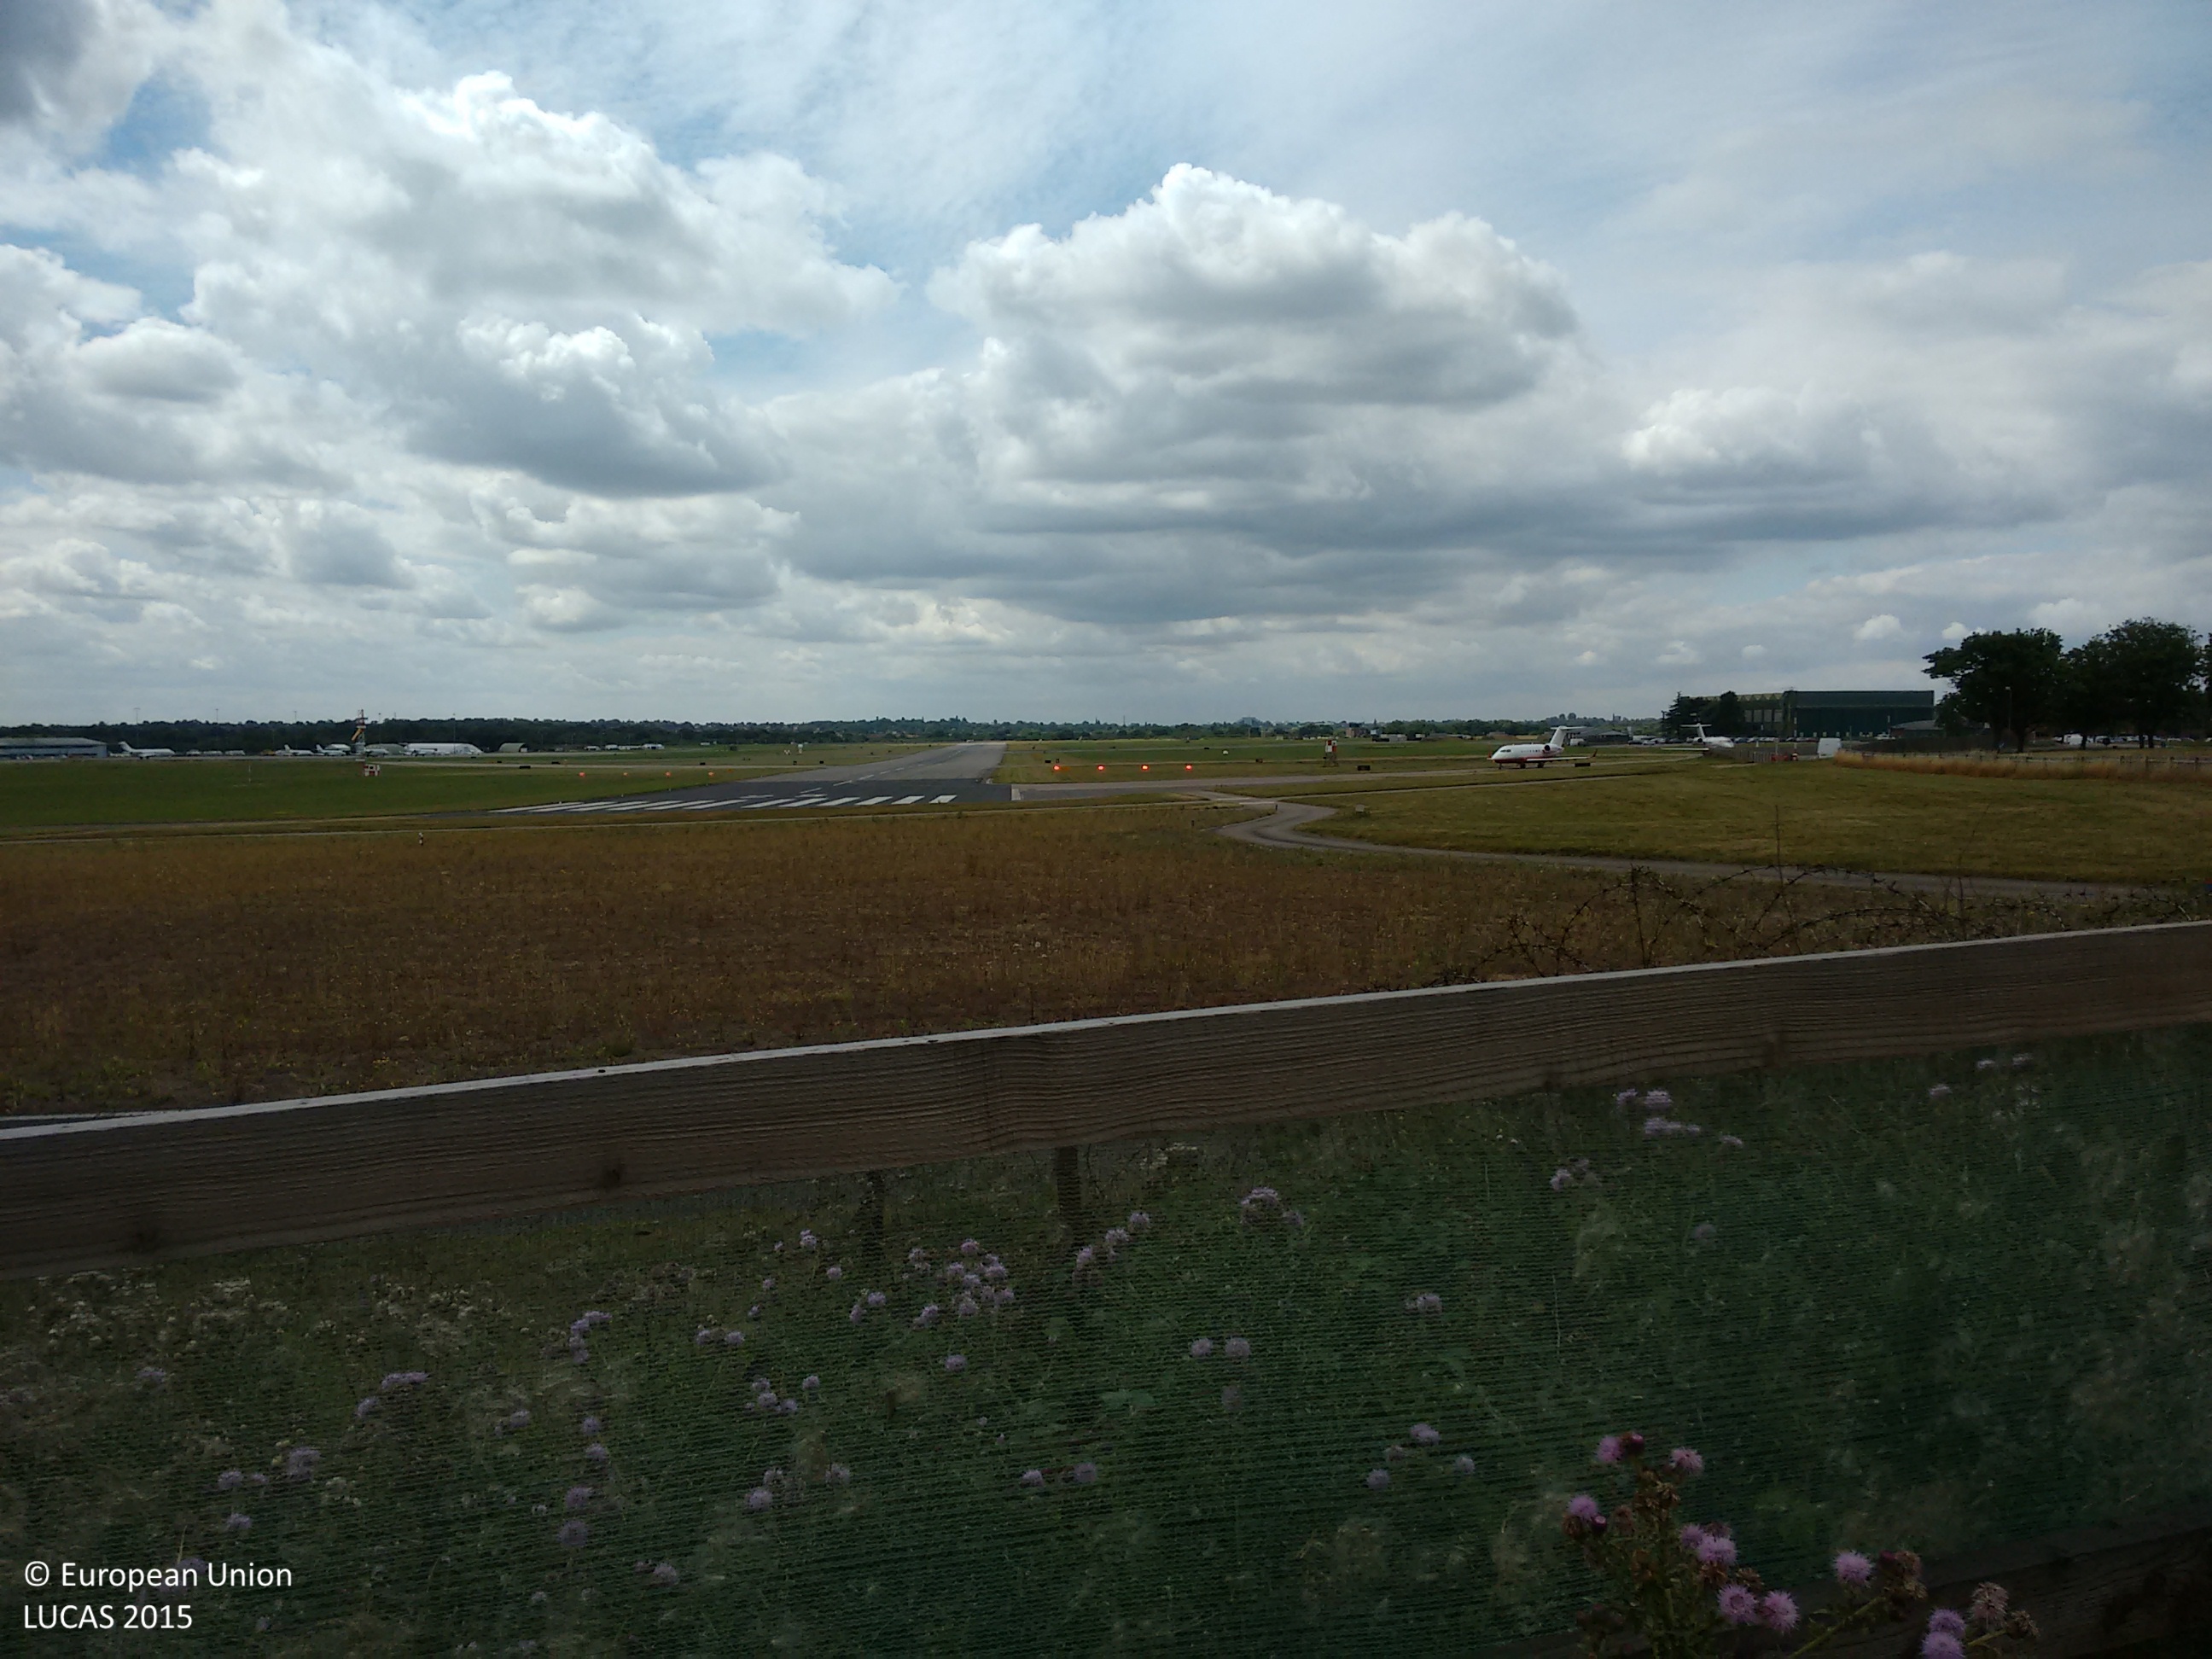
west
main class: Grassland
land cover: Grassland without tree/shrub cover
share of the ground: > 75 %
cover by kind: herbaceous plants 100 %
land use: Air transport
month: July
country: GB
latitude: 51.5561
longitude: -0.4076
